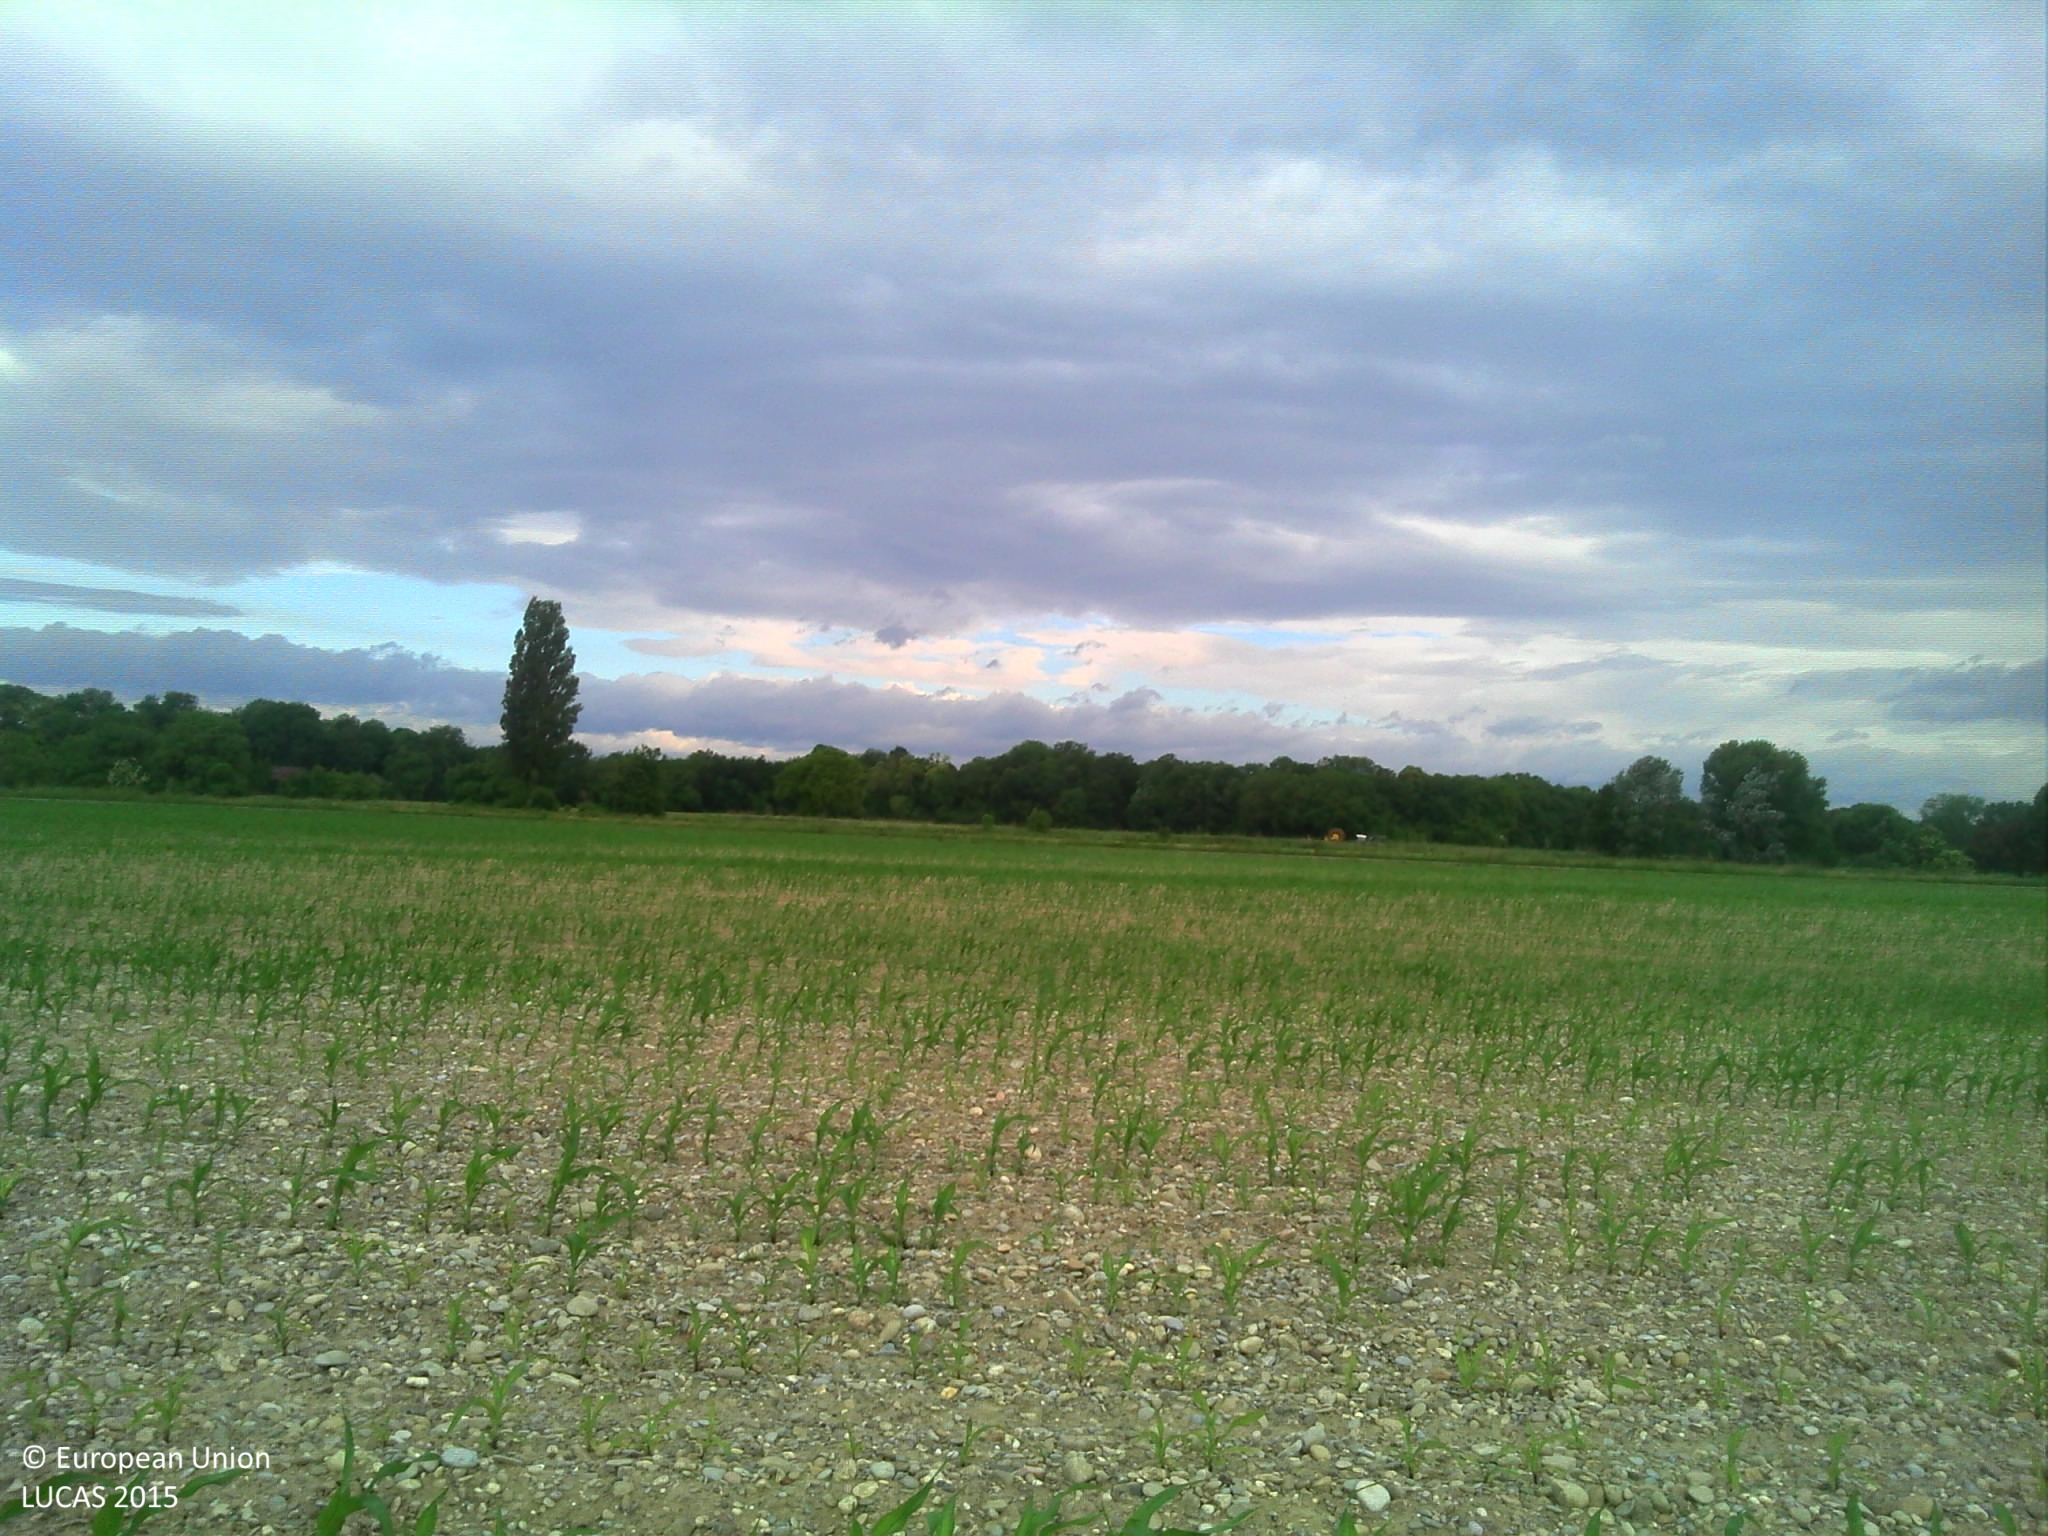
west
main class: Cropland
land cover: Maize
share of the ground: < 10 %
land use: Agriculture (excluding fallow land and kitchen gardens)
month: June
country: FR
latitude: 47.9815
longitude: 7.6030
